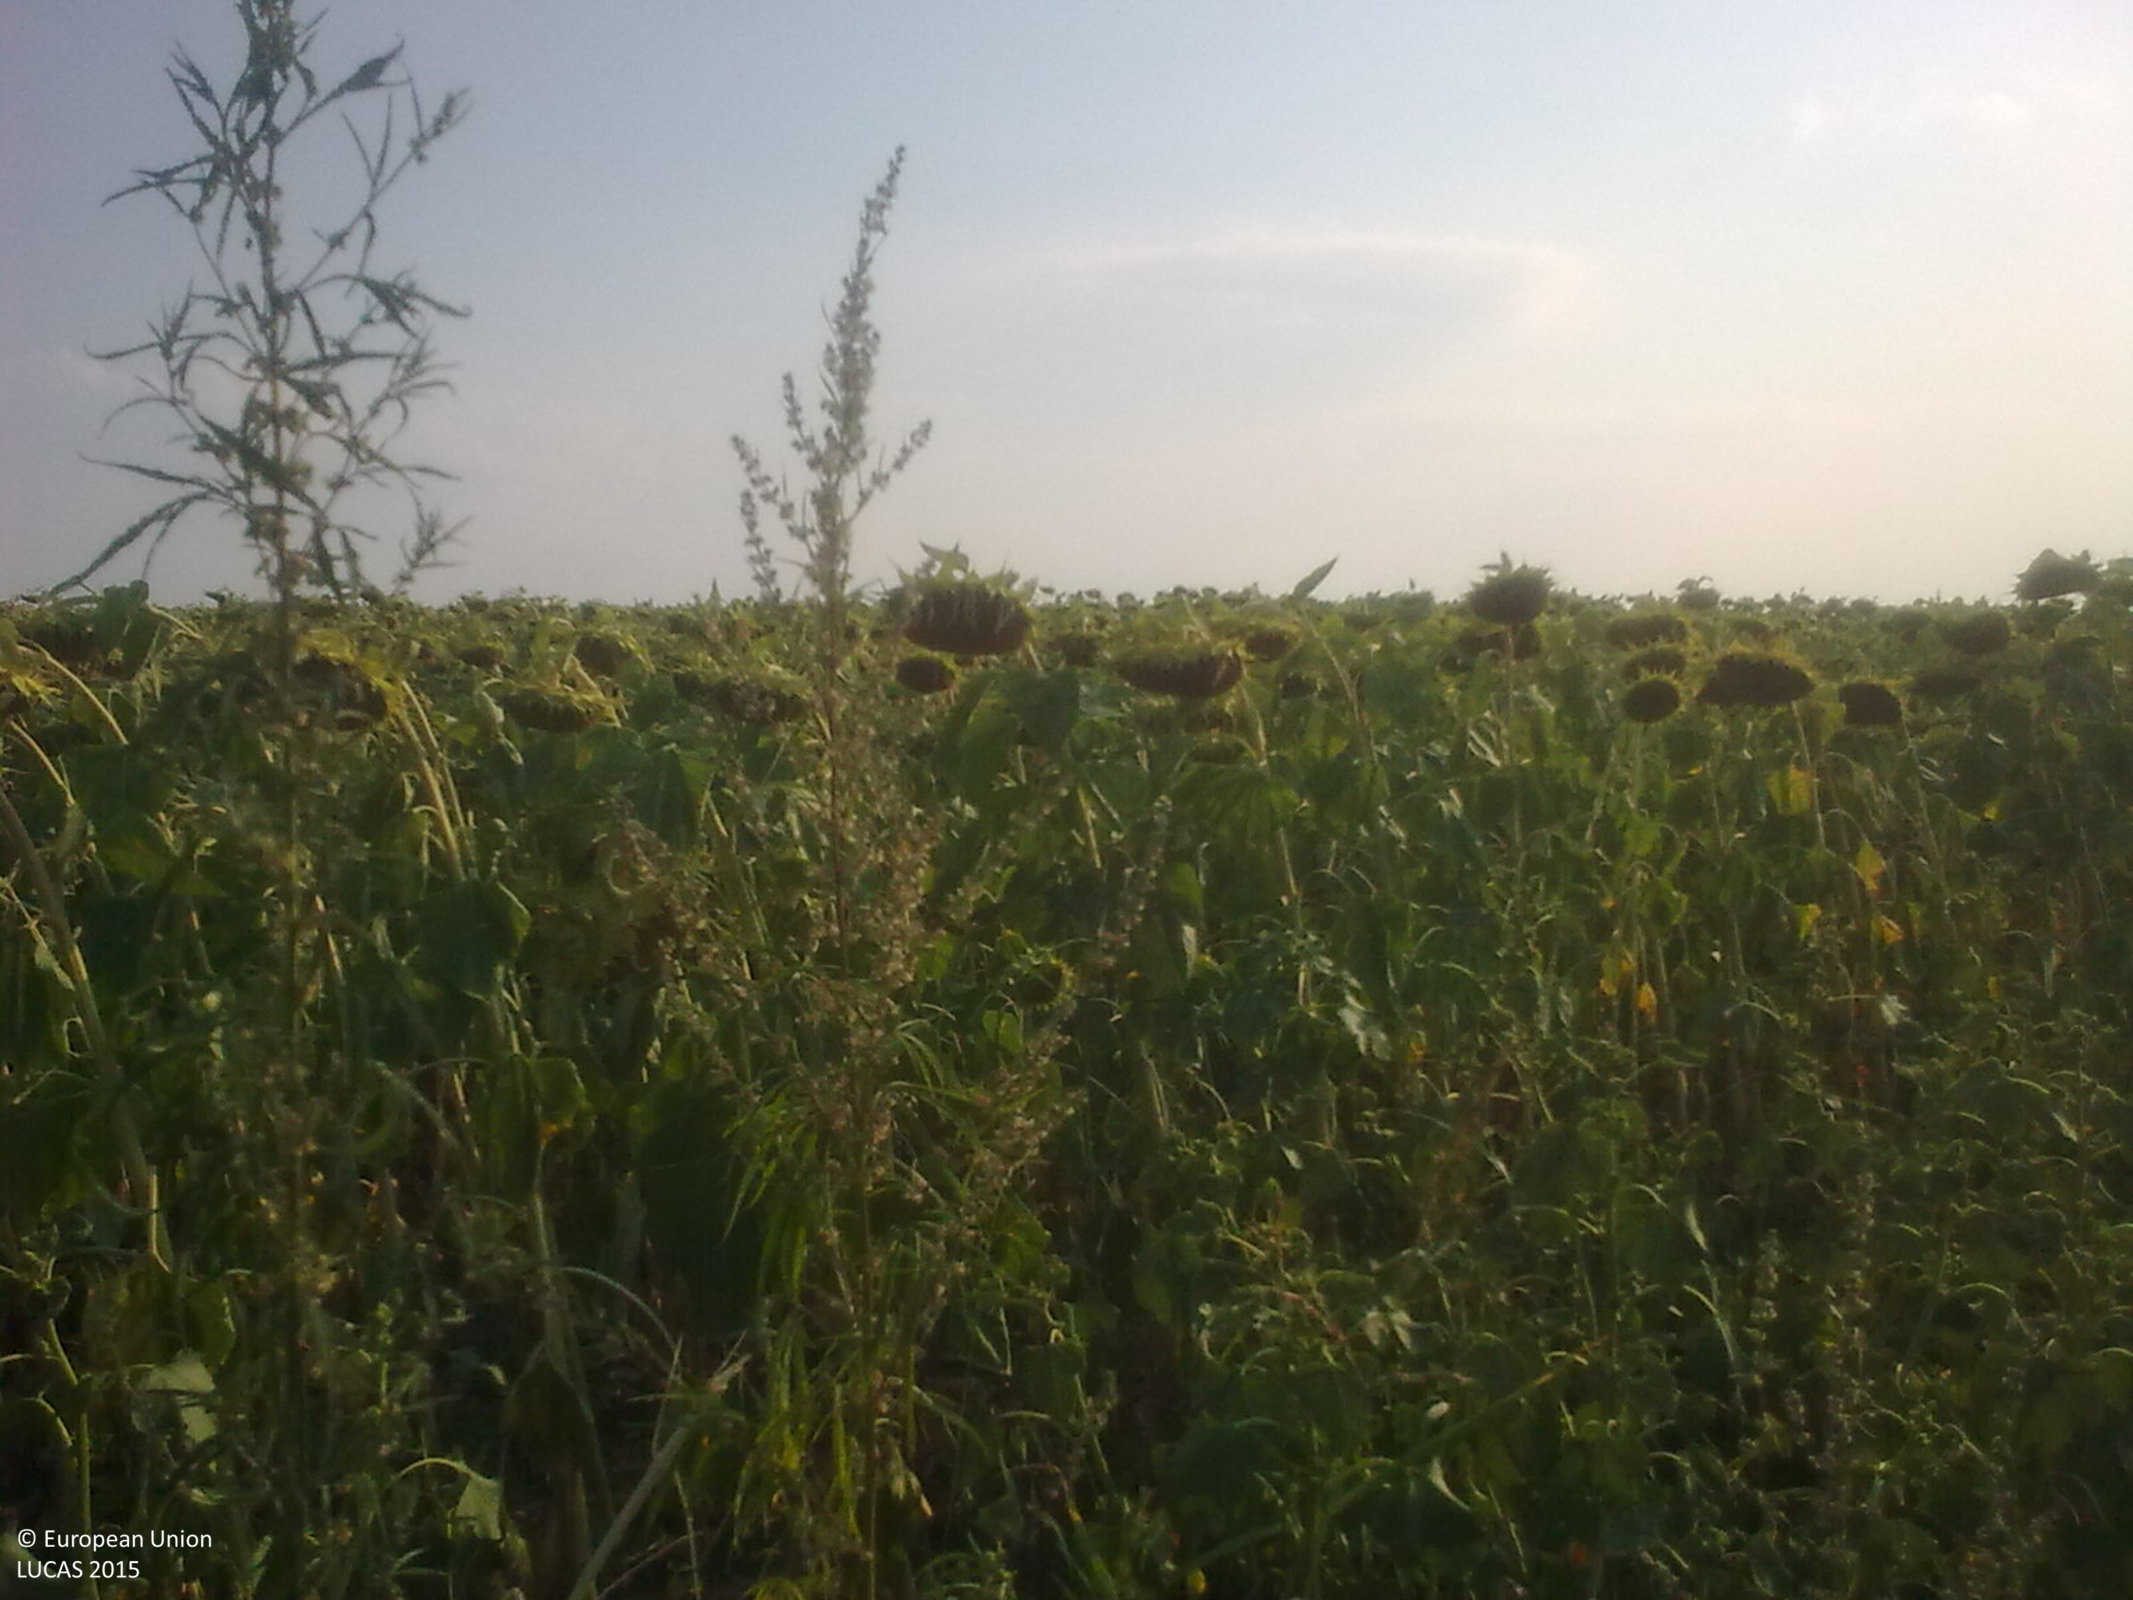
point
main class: Cropland
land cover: Sunflower
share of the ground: > 75 %
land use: Agriculture (excluding fallow land and kitchen gardens)
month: July
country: BG
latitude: 43.4092
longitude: 25.3027
